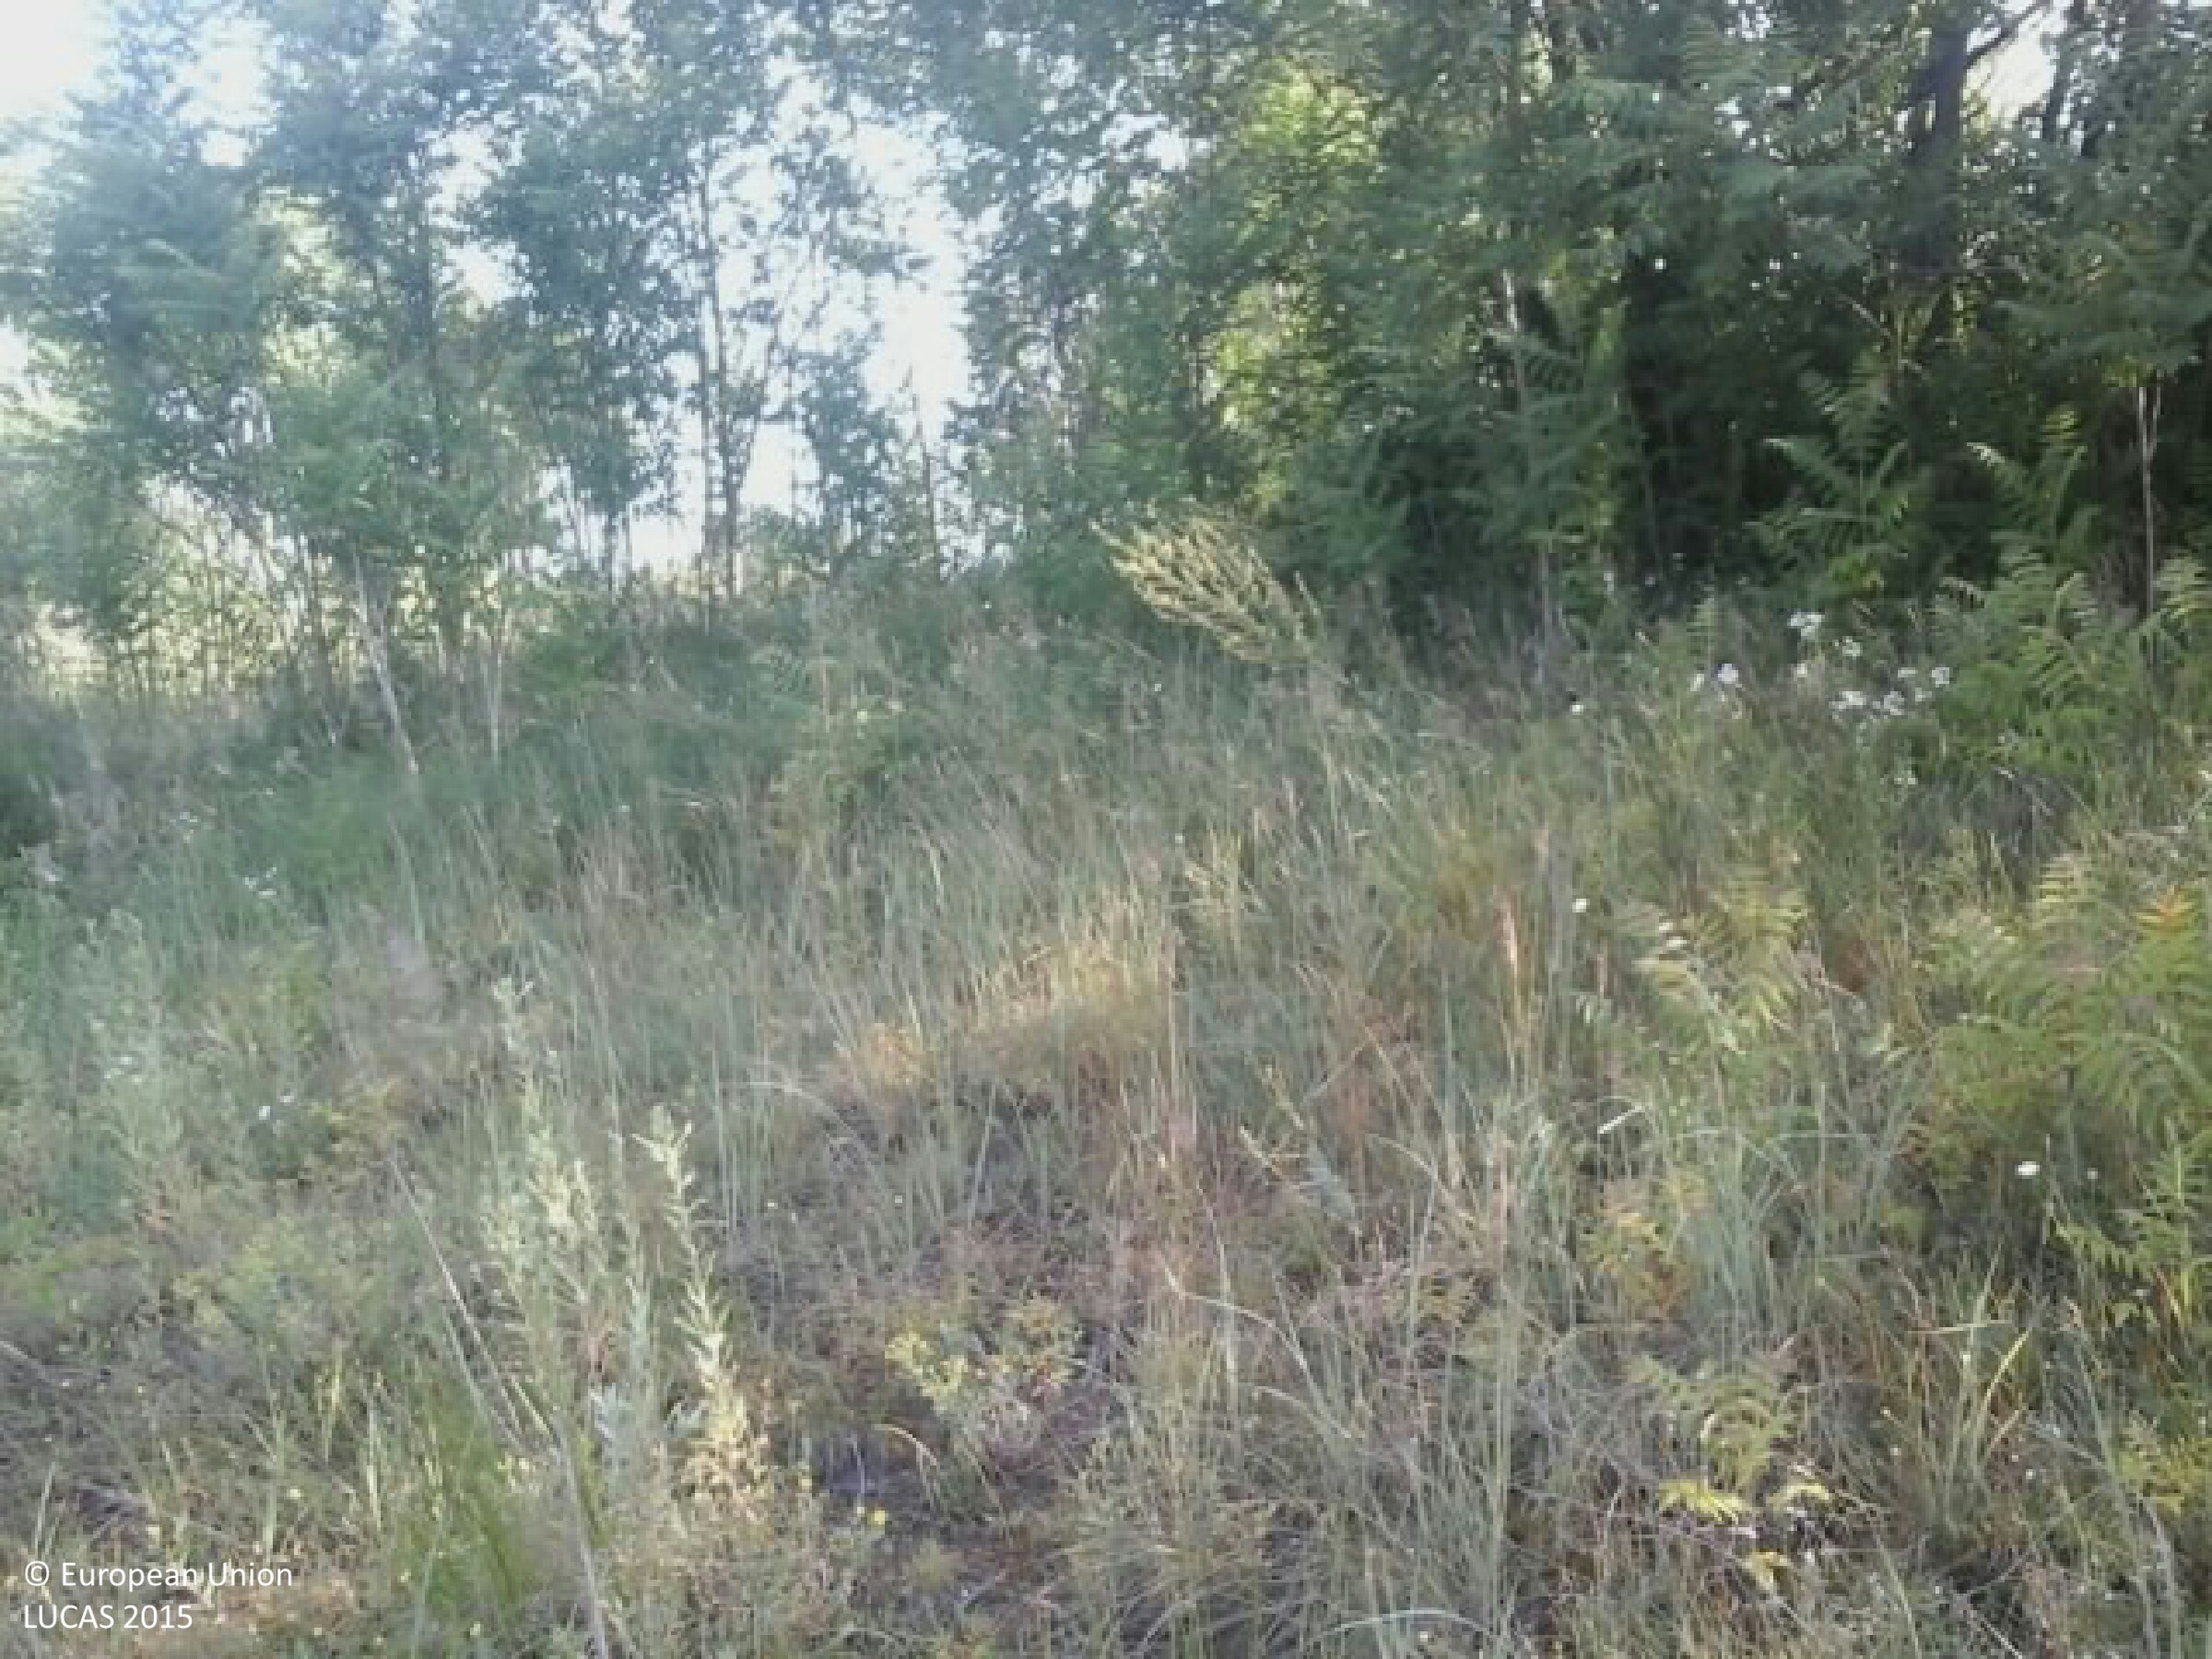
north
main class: Grassland
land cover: Grassland with sparse tree/shrub cover
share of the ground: > 75 %
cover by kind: herbaceous plants 85 %, shrubs 10 %, broadleaved forest trees 5 %
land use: Semi-natural and natural areas not in use
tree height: < 5 m
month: June
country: HU
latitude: 46.1893
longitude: 18.9913
